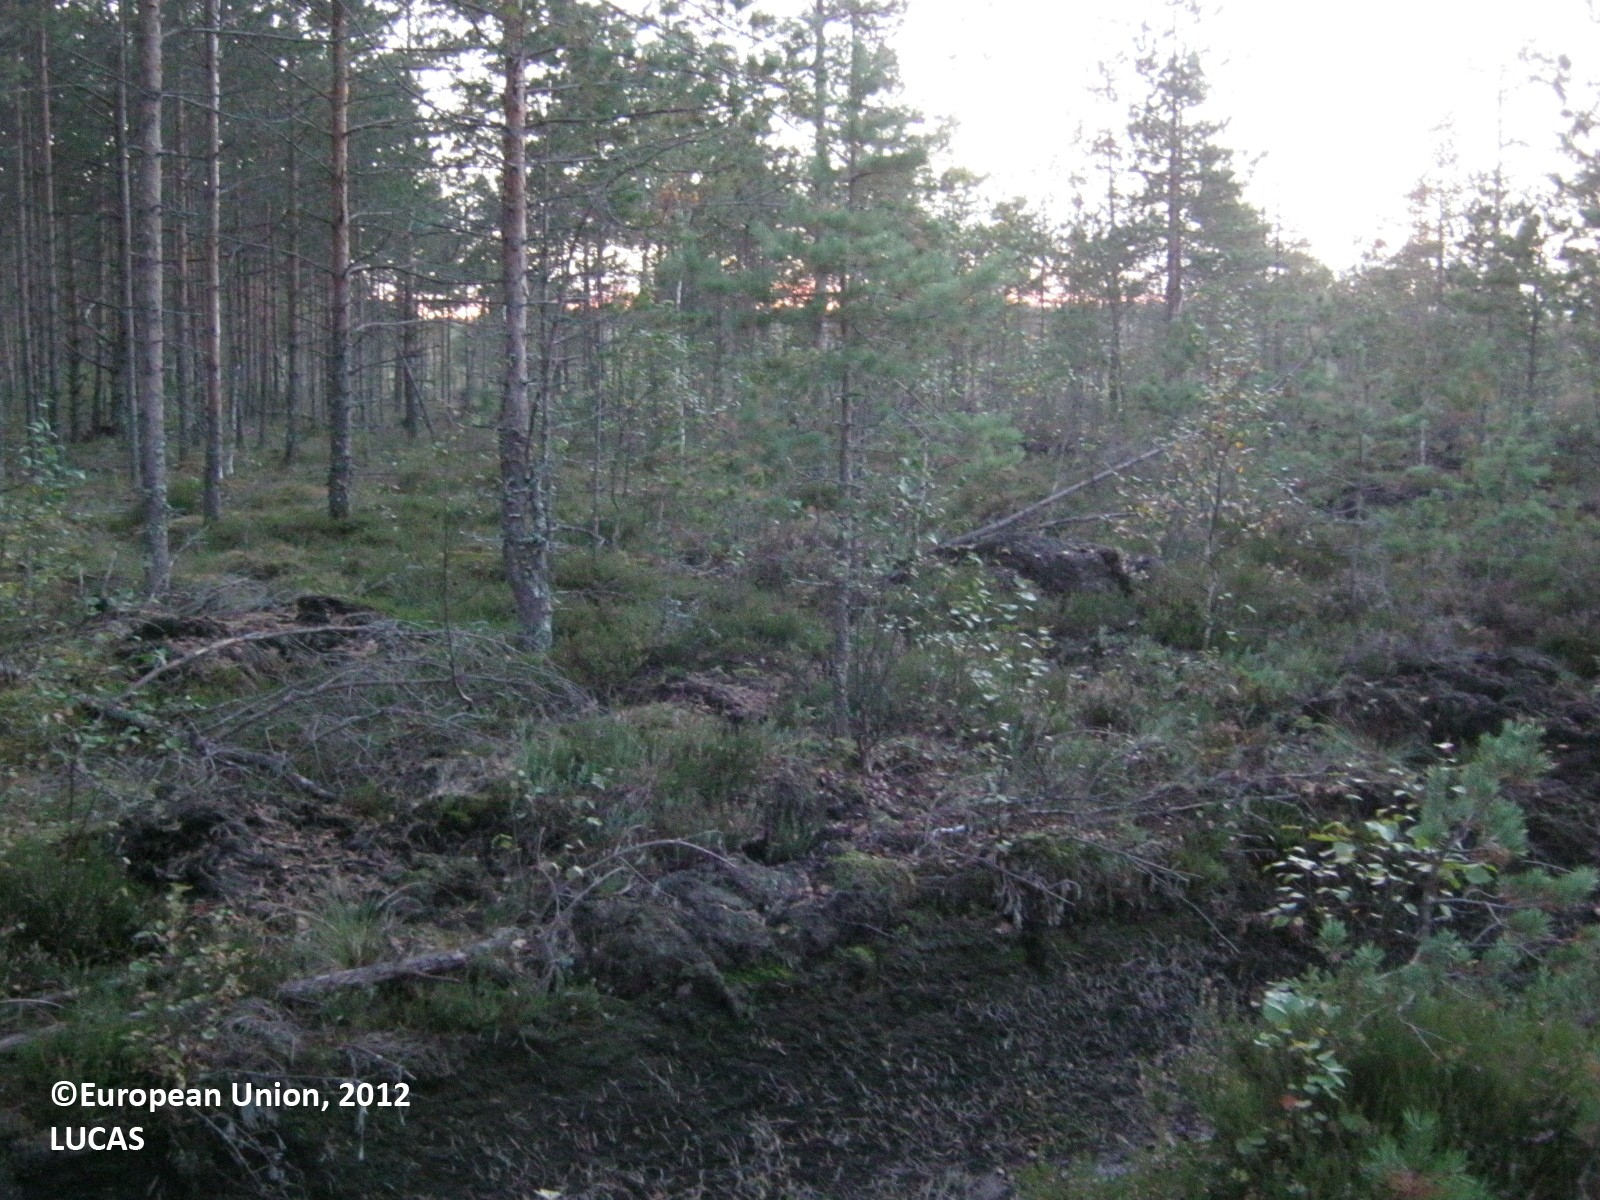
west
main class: Woodland
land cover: Pine dominated mixed woodland
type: boreal forest
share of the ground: 50 - 75 %
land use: Forestry
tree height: > 5 m
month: September
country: FI
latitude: 60.8405
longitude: 27.8774
